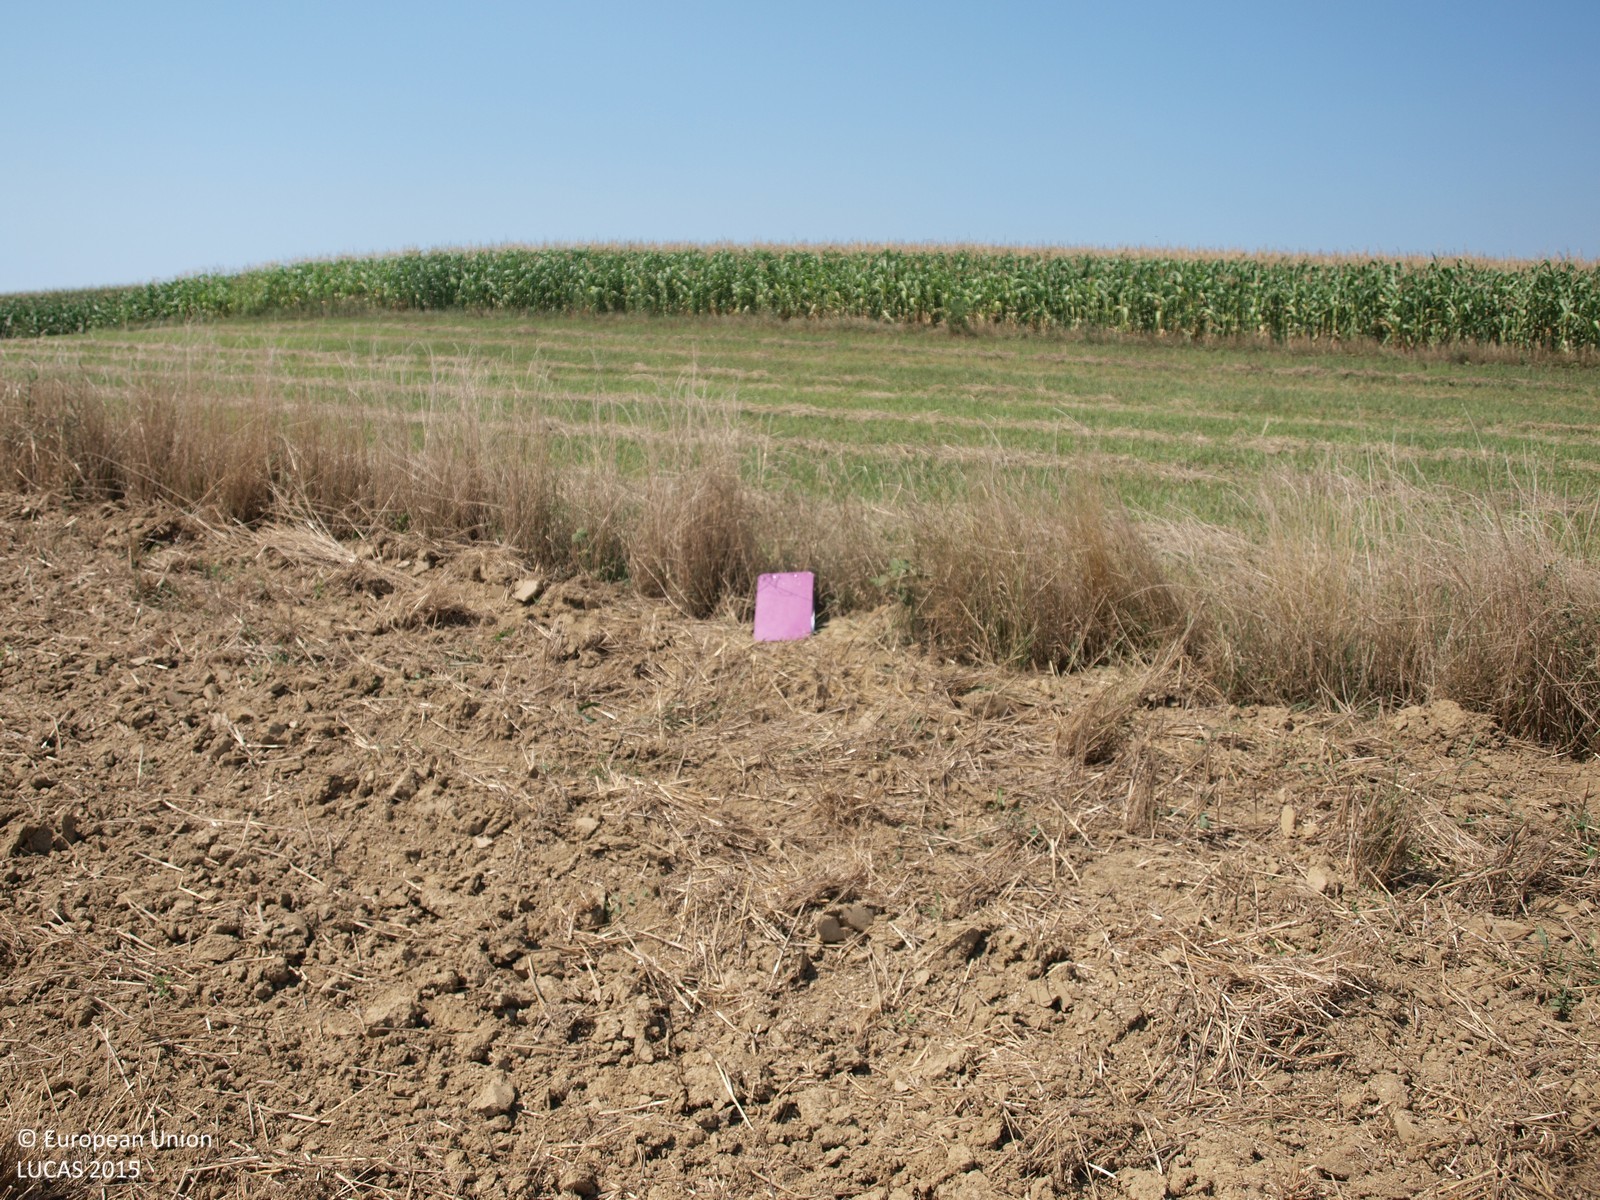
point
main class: Cropland
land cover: Oats
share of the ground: > 75 %
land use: Agriculture (excluding fallow land and kitchen gardens)
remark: Harvested field
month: August
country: HR
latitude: 45.9865
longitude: 16.5707
